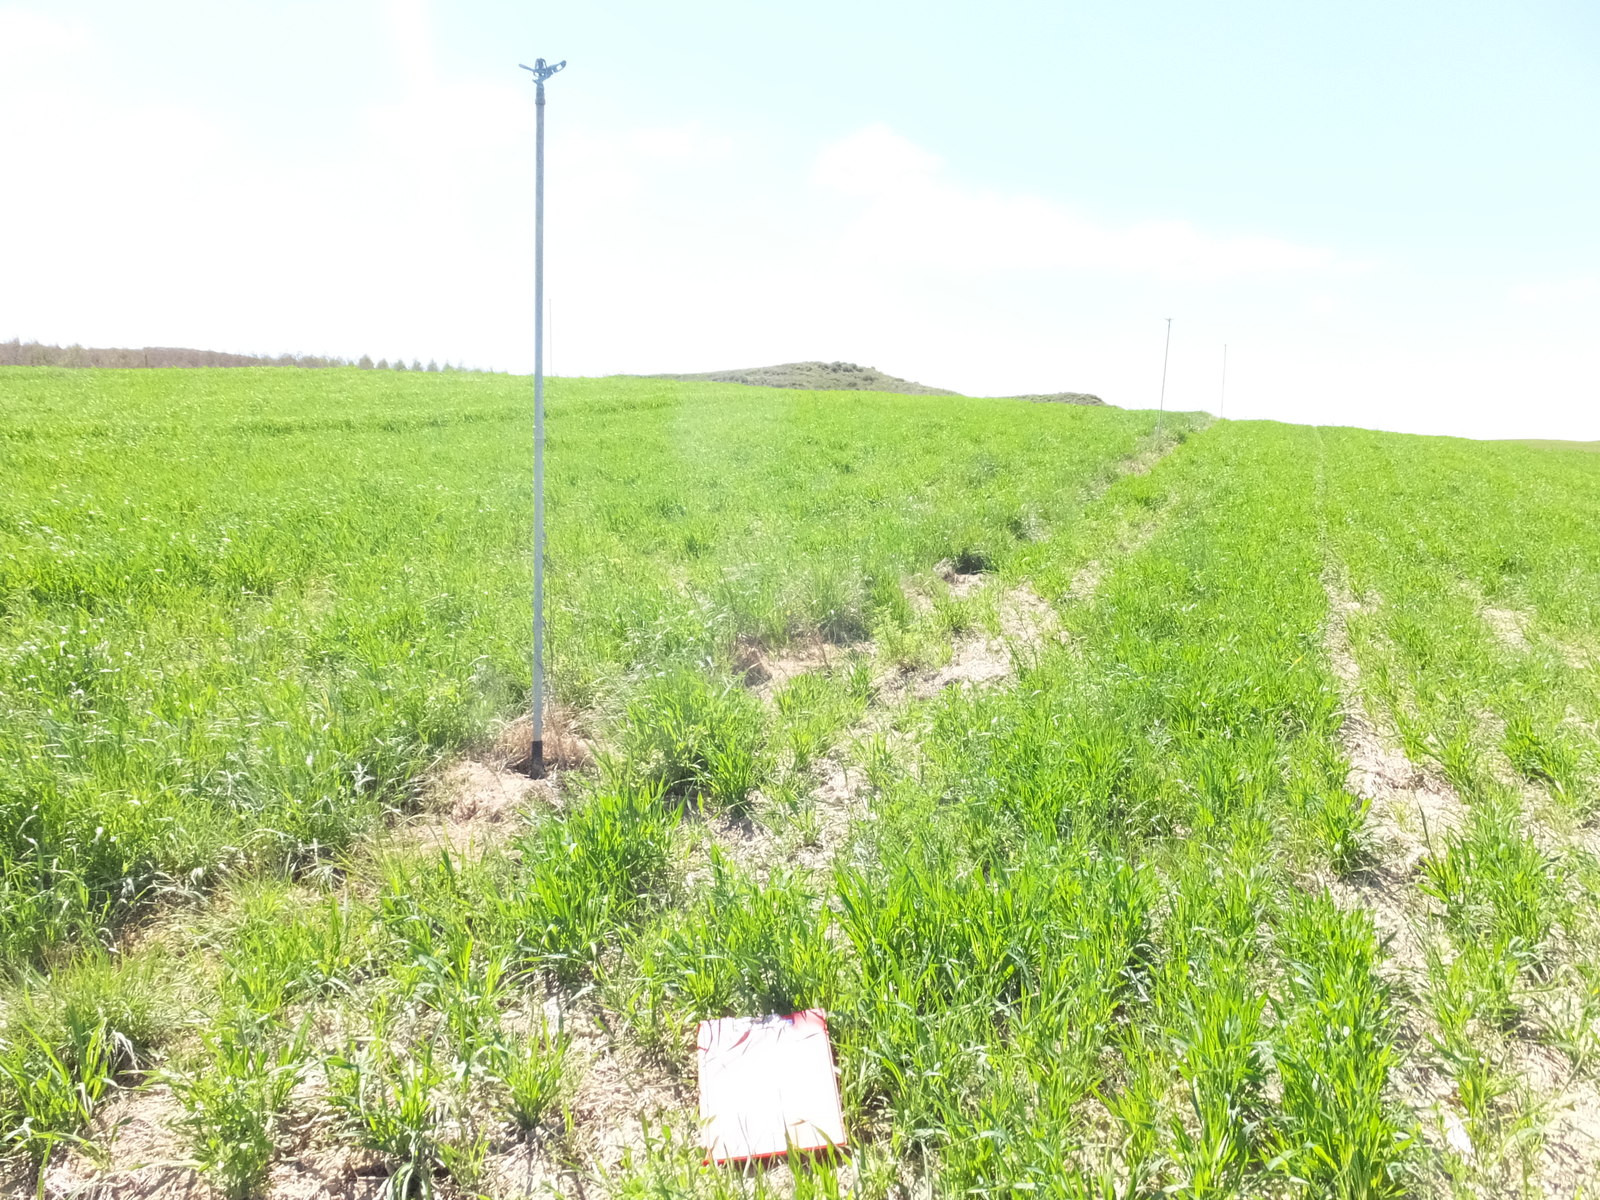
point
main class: Cropland
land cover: Durum wheat
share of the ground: > 75 %
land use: Agriculture (excluding fallow land and kitchen gardens)
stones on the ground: < 10 %
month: April
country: ES
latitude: 41.7122
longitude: -0.2700
